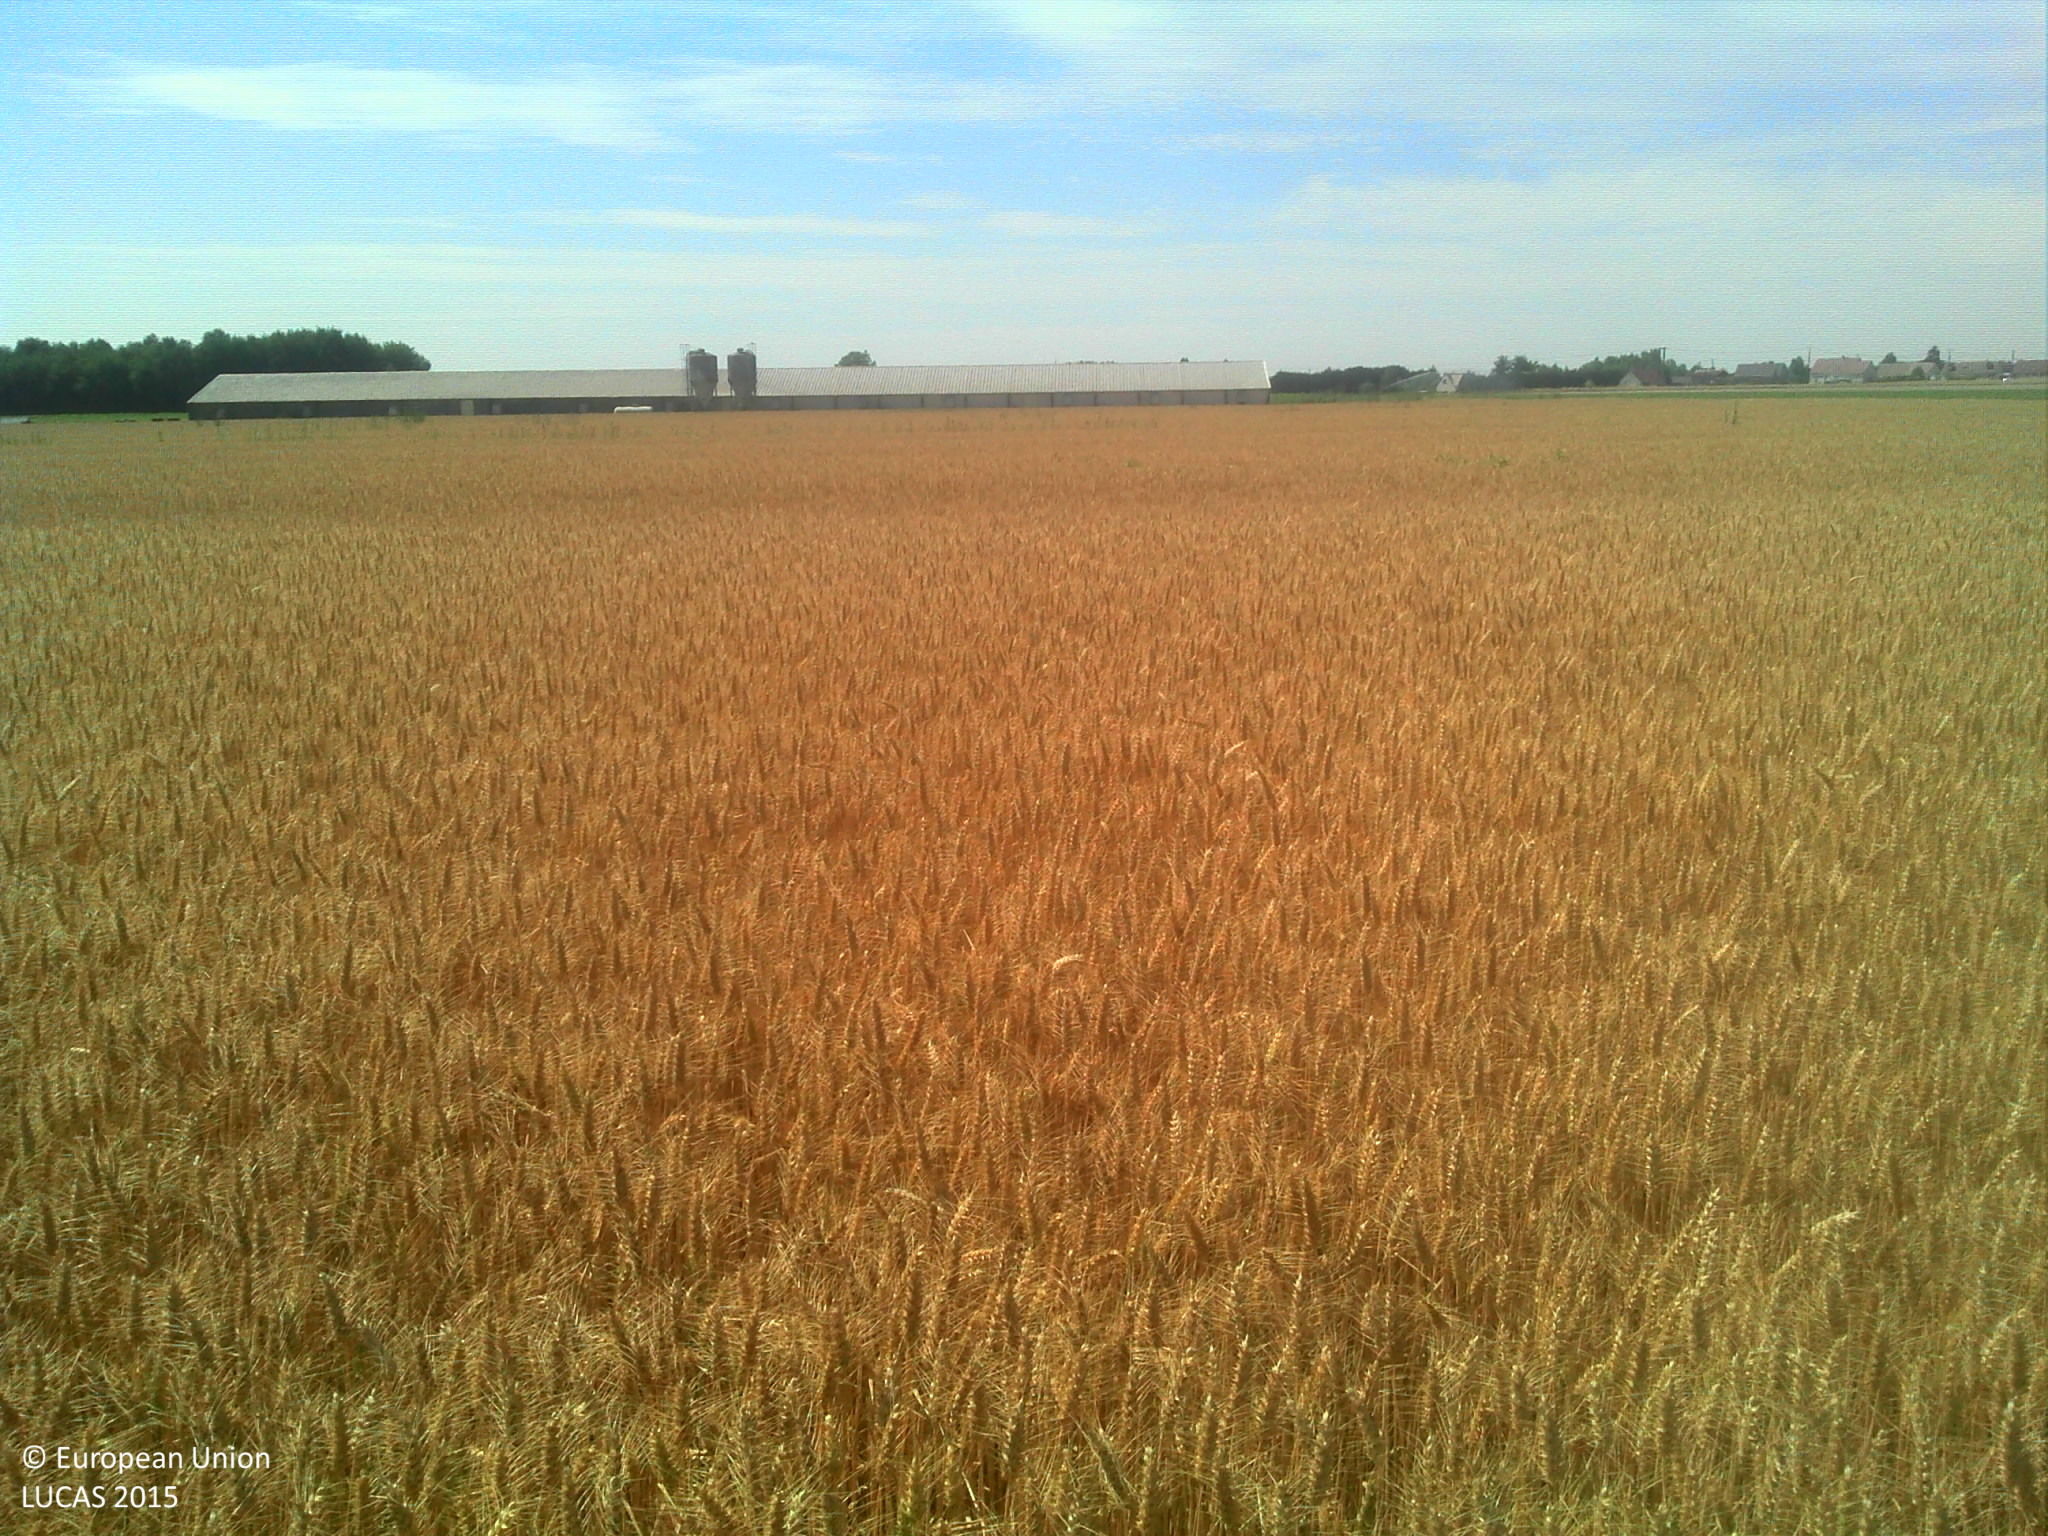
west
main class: Cropland
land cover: Durum wheat
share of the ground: > 75 %
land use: Agriculture (excluding fallow land and kitchen gardens)
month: June
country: FR
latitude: 47.4098
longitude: 1.5448
